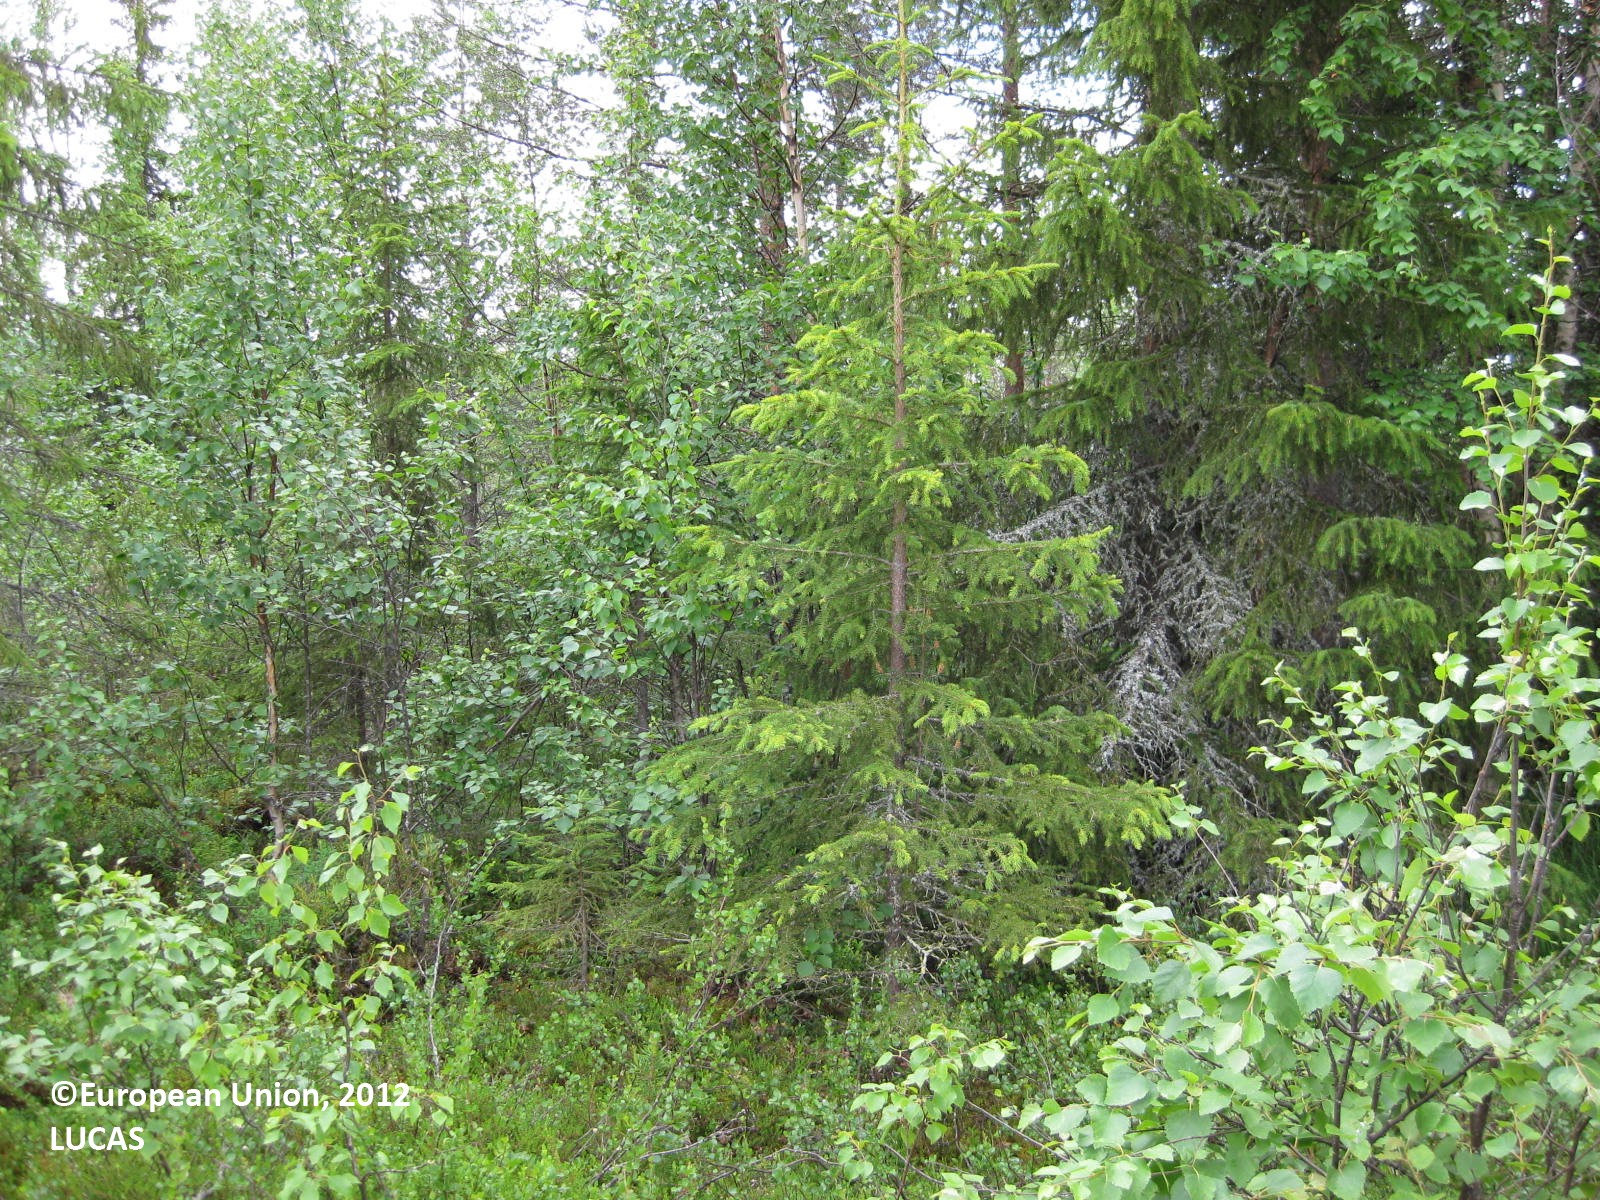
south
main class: Woodland
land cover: Other mixed woodland
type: boreal forest
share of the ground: 25 - 50 %
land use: Forestry
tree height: > 5 m
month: July
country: FI
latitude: 65.4216
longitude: 28.3651
